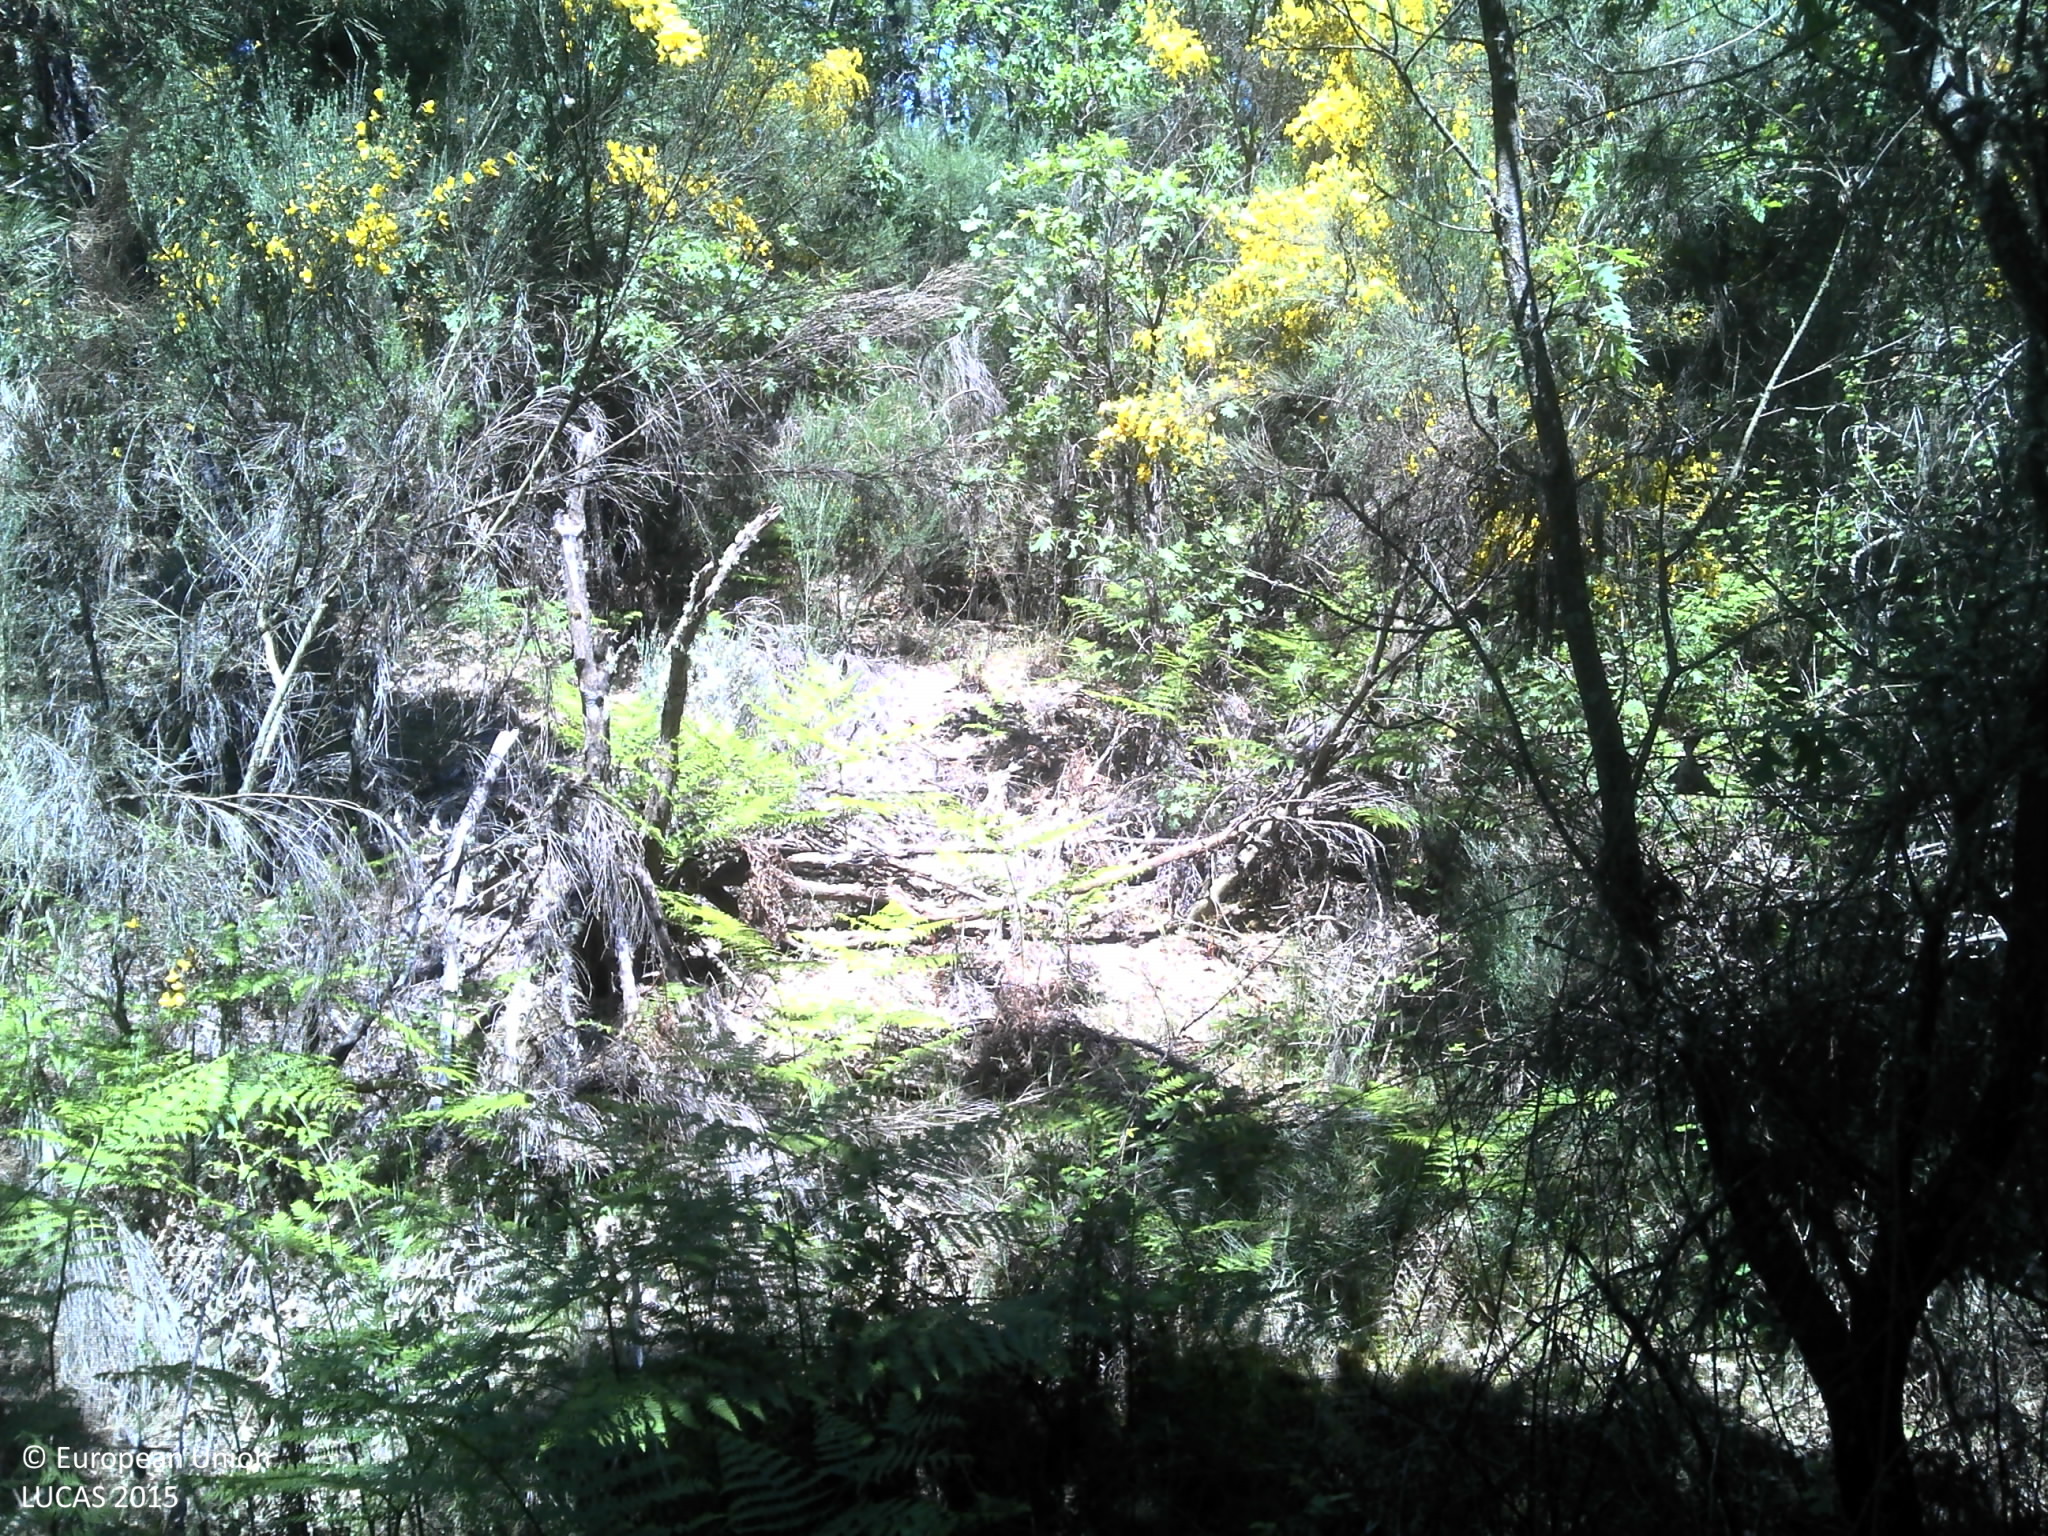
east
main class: Woodland
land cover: Pine dominated coniferous woodland
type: coniferous forest of the mediterranean region
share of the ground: 50 - 75 %
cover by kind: coniferous forest trees 75 %, unconsolidated bare surface 20 %, herbaceous plants 5 %
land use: Forestry
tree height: > 5 m
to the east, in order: Pine dominated coniferous woodland; Shrubland with sparse tree cover; Pine dominated coniferous woodland; Tracks; Lines of trees; Dry stone walls; Spontaneously vegetated surfaces; Shrubland with sparse tree cover; Dry stone walls; Single bushes/trees; Spontaneously vegetated surfaces; Dry stone walls; Broadleaved woodland; Dry stone walls; Broadleaved woodland
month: May
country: PT
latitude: 40.5014
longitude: -7.2261
